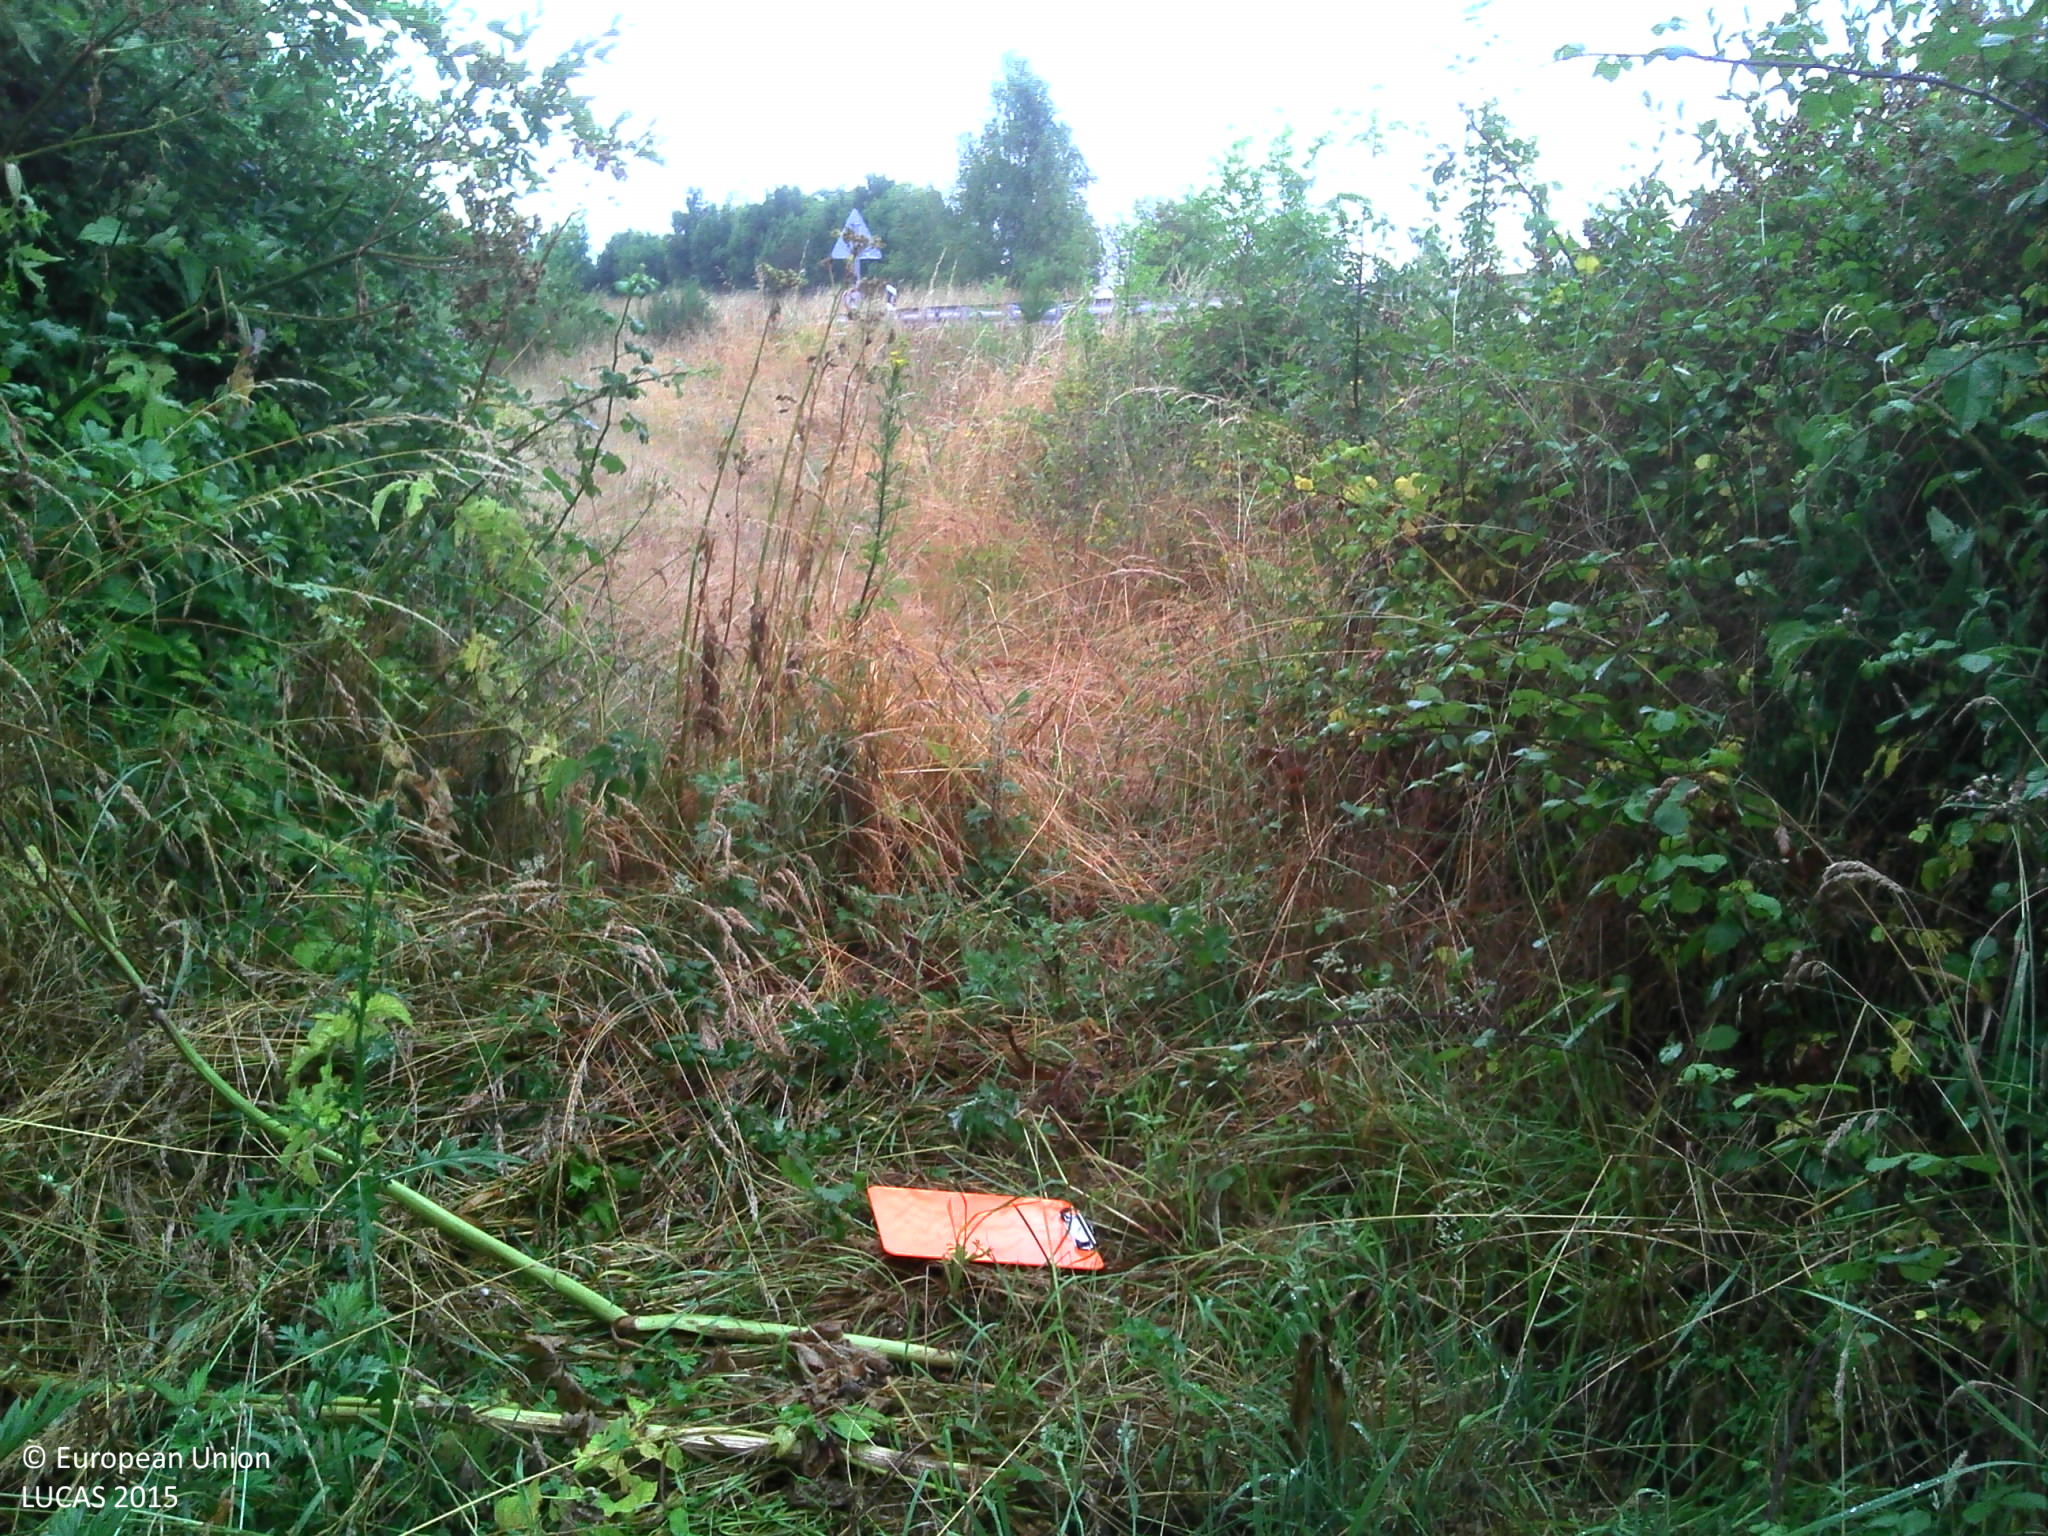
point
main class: Shrubland
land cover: Shrubland with sparse tree cover
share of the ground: > 75 %
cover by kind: shrubs 95 %, broadleaved forest trees 5 %
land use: Road transport
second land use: Semi-natural and natural areas not in use
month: July
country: FR
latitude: 47.1988
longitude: -1.8602
